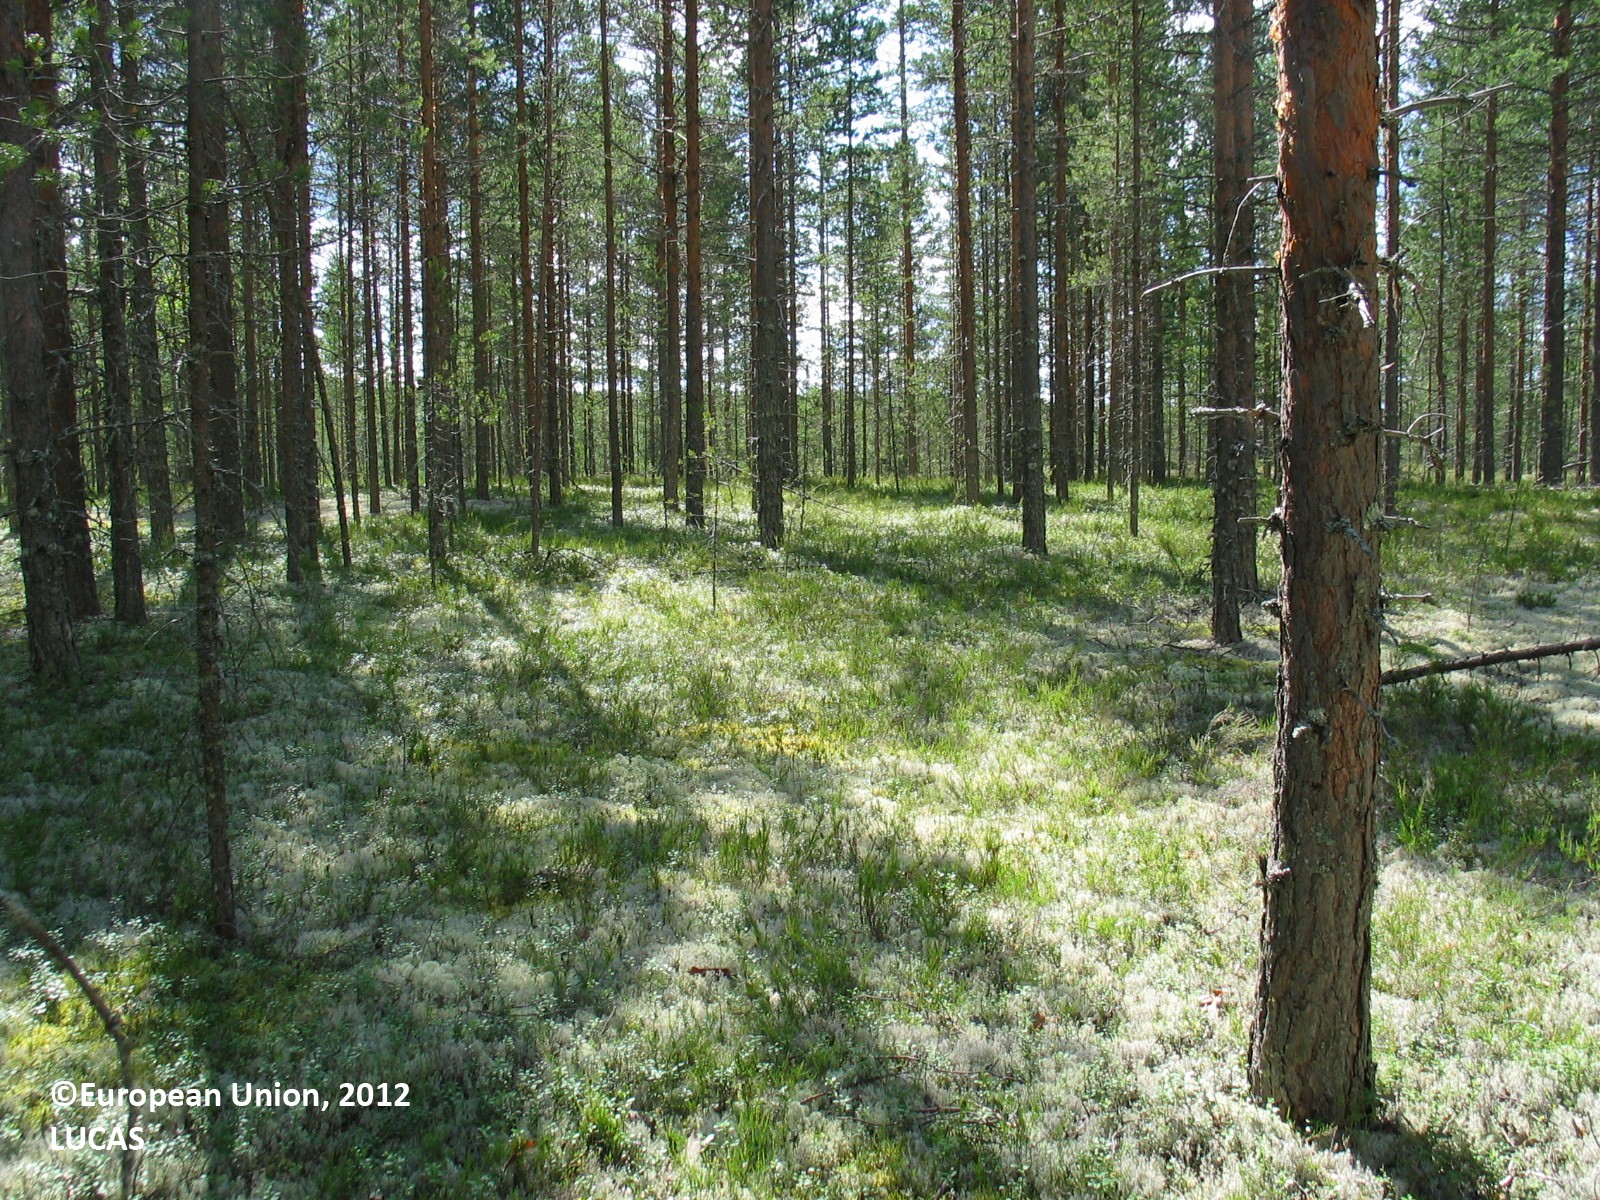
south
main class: Woodland
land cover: Pine dominated coniferous woodland
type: boreal forest
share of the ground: 25 - 50 %
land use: Amenities, museums, leisure
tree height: > 5 m
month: July
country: FI
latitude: 64.5860
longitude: 26.4648
